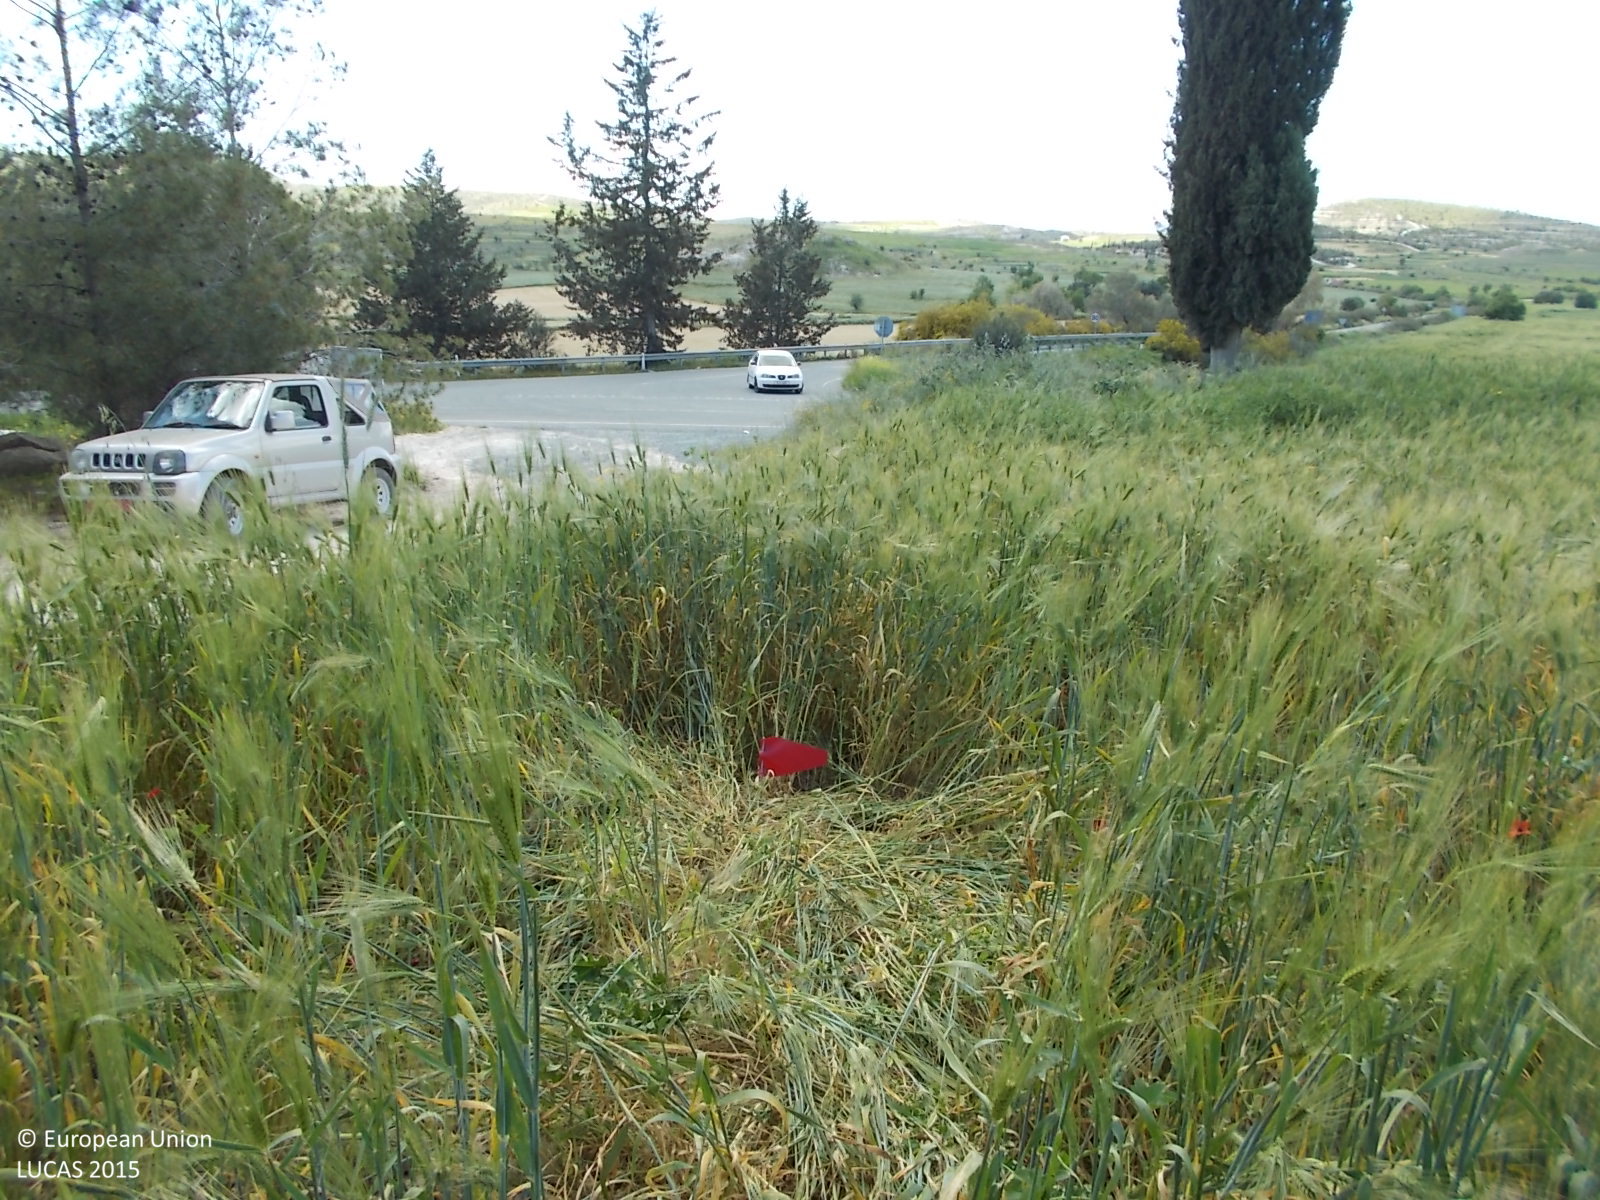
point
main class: Cropland
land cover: Barley
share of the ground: > 75 %
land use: Agriculture (excluding fallow land and kitchen gardens)
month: April
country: CY
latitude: 35.0026
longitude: 33.4998
